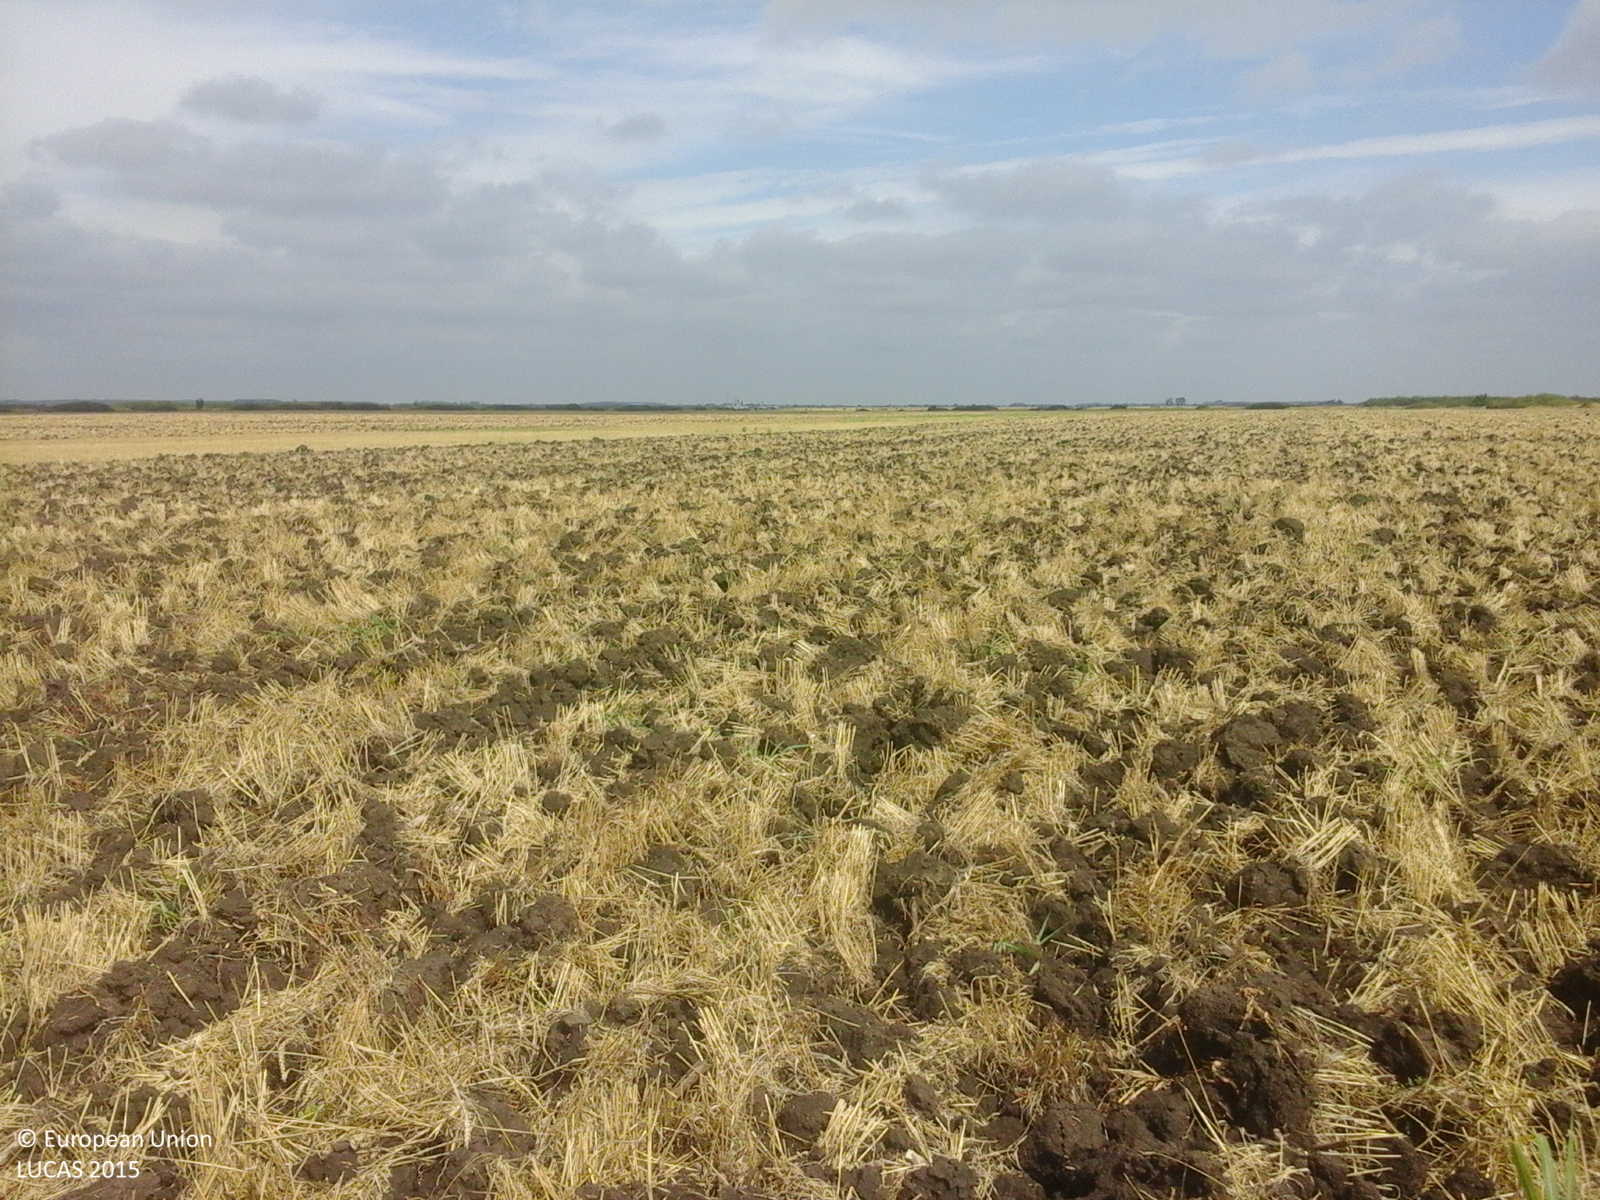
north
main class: Cropland
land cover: Common wheat
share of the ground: 10 - 25 %
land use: Agriculture (excluding fallow land and kitchen gardens)
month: August
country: RO
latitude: 45.3175
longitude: 21.2670
